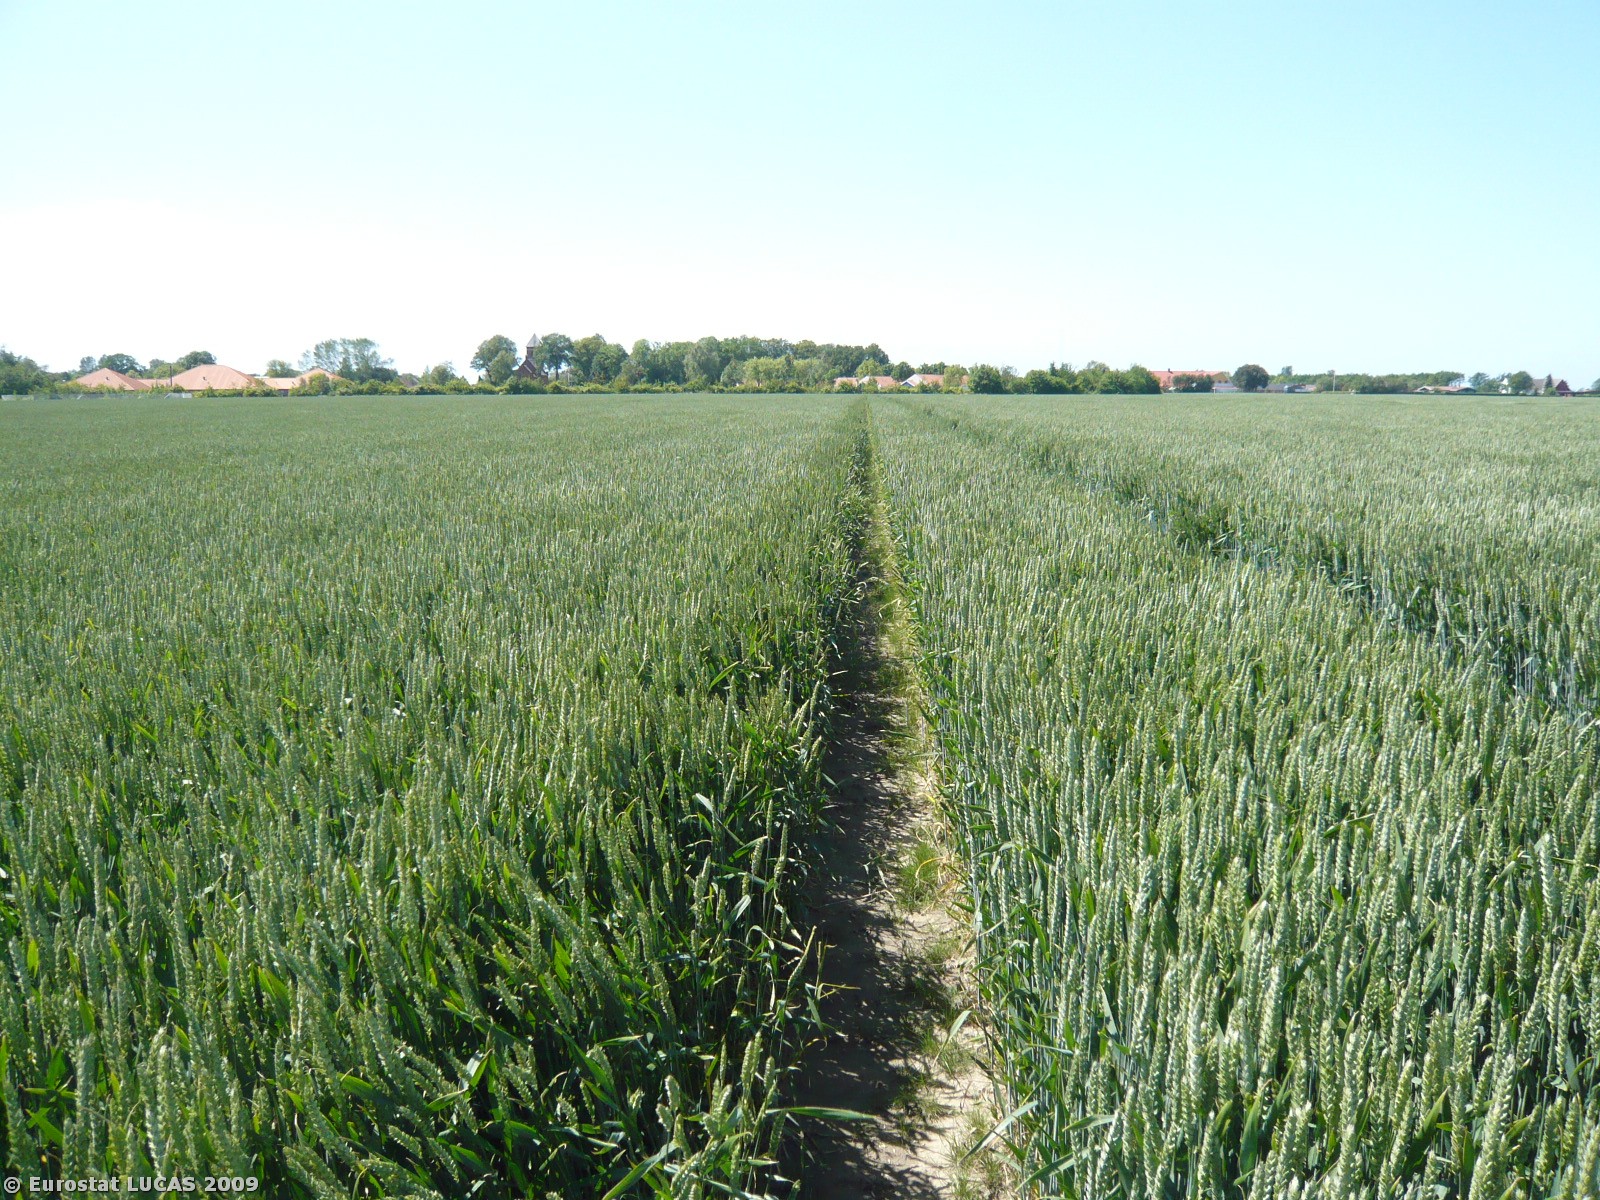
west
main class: Cropland
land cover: Common wheat
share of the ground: > 75 %
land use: Agriculture (excluding fallow land and kitchen gardens)
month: June
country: DK
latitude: 54.7621
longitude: 11.1958
